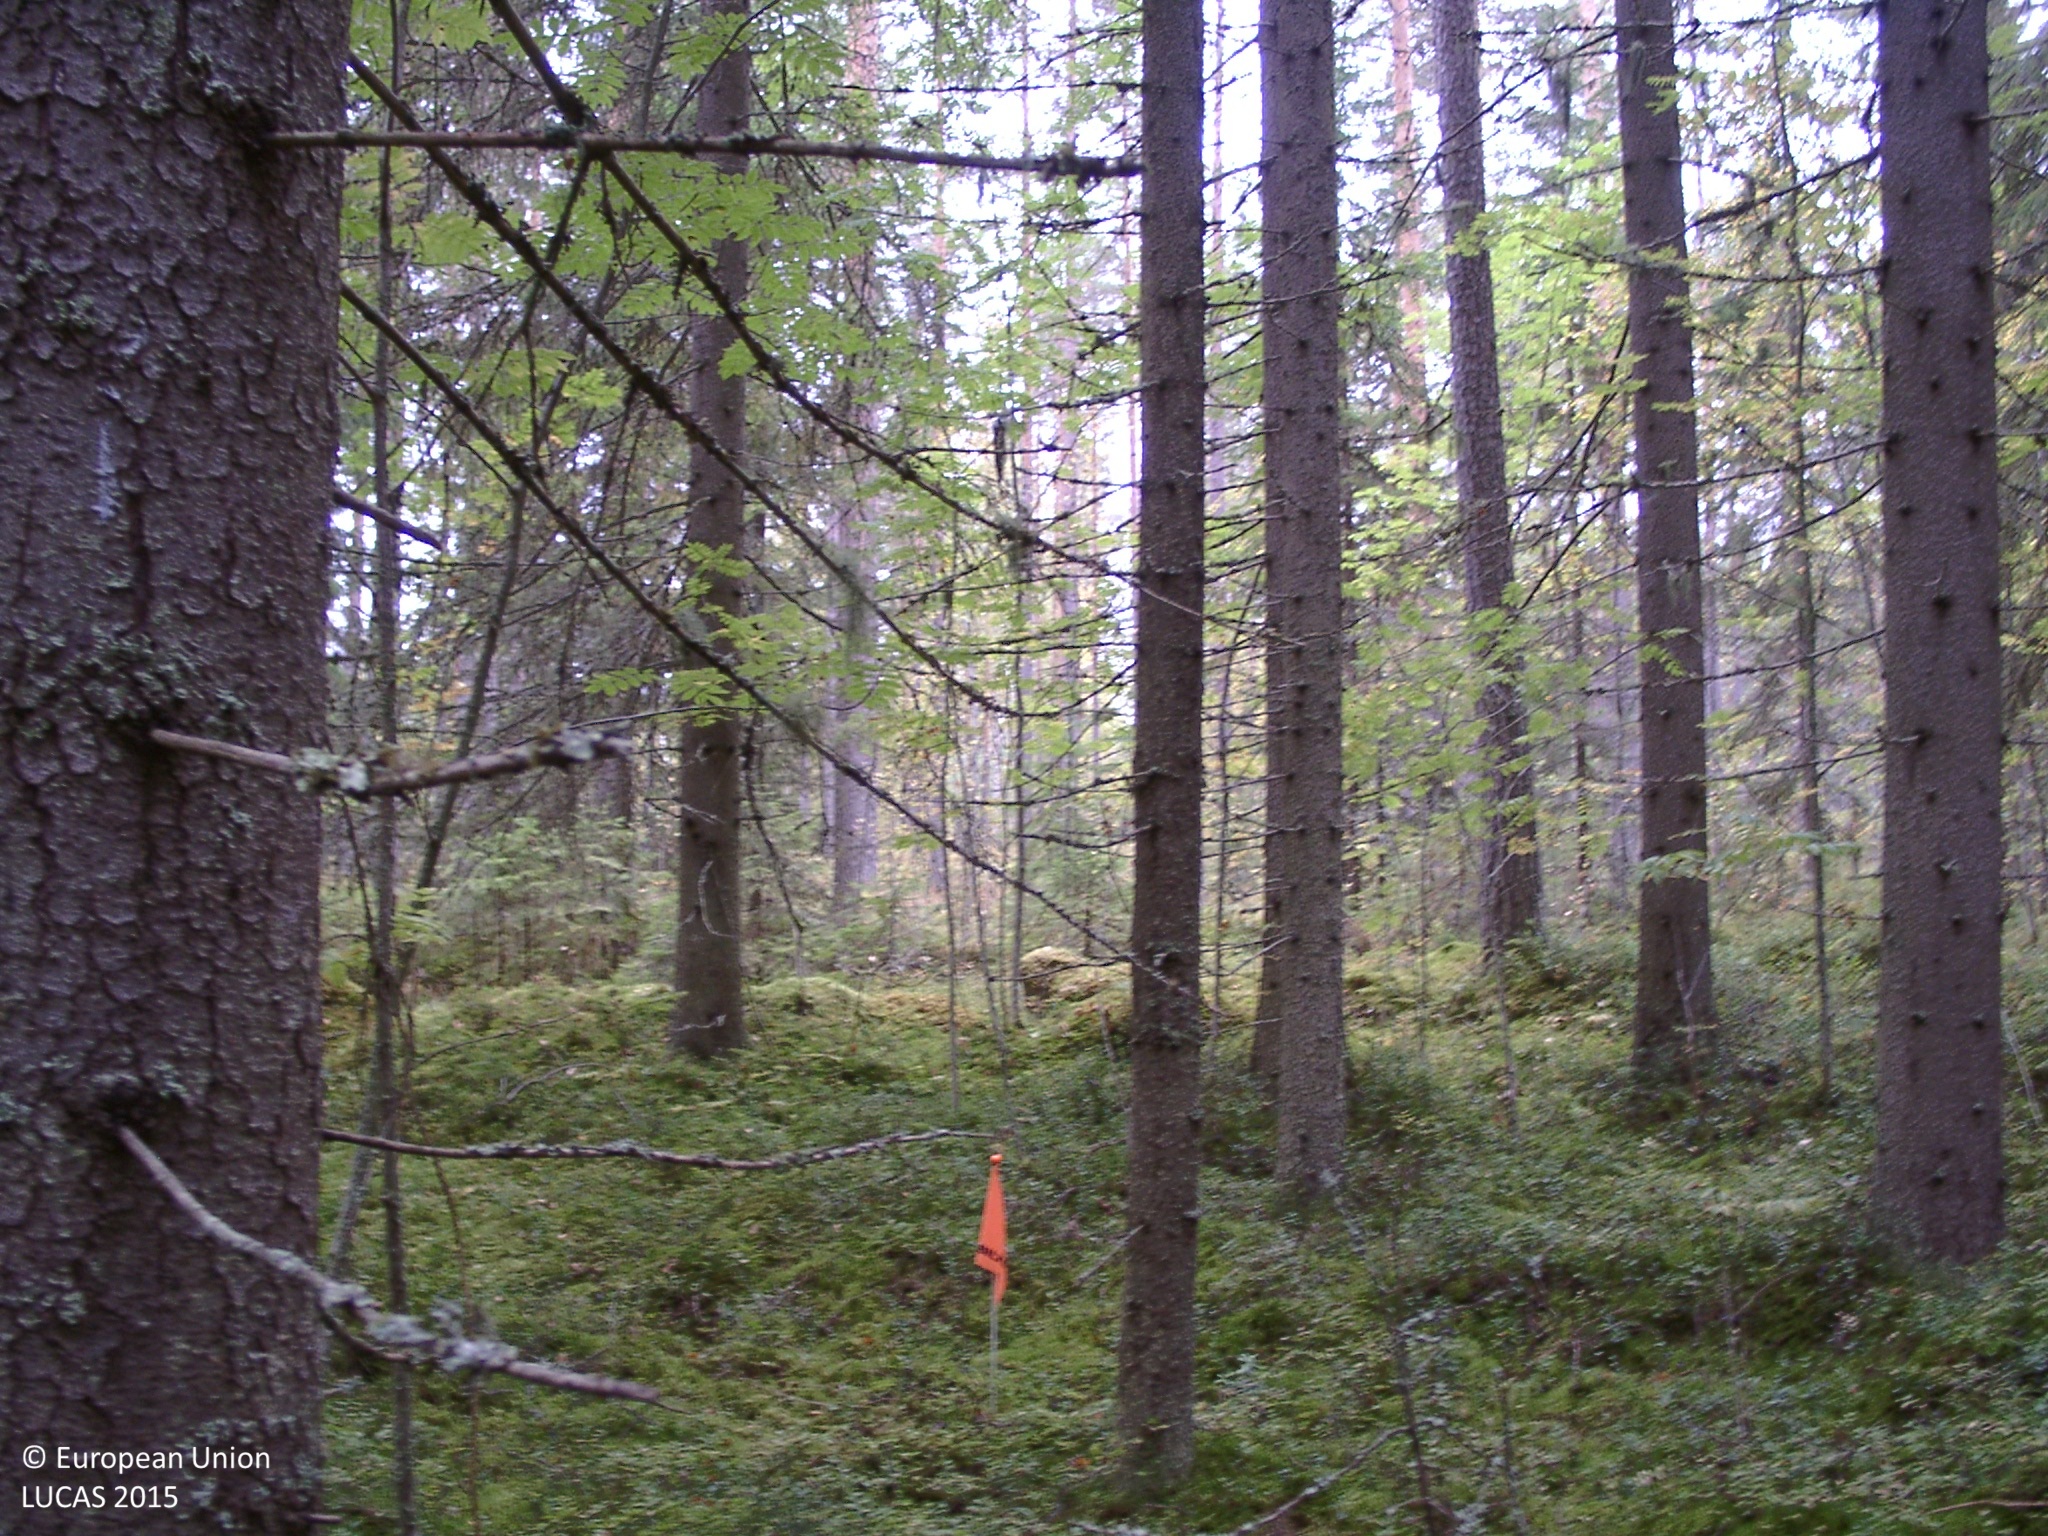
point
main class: Woodland
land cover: Spruce dominated coniferous woodland
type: boreal forest
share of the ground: > 75 %
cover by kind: coniferous forest trees 70 %, lichens and mosses 15 %, broadleaved forest trees 10 %, shrubs 5 %
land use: Forestry
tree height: > 5 m
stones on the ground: < 10 %
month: September
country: FI
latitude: 62.6481
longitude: 25.7032
